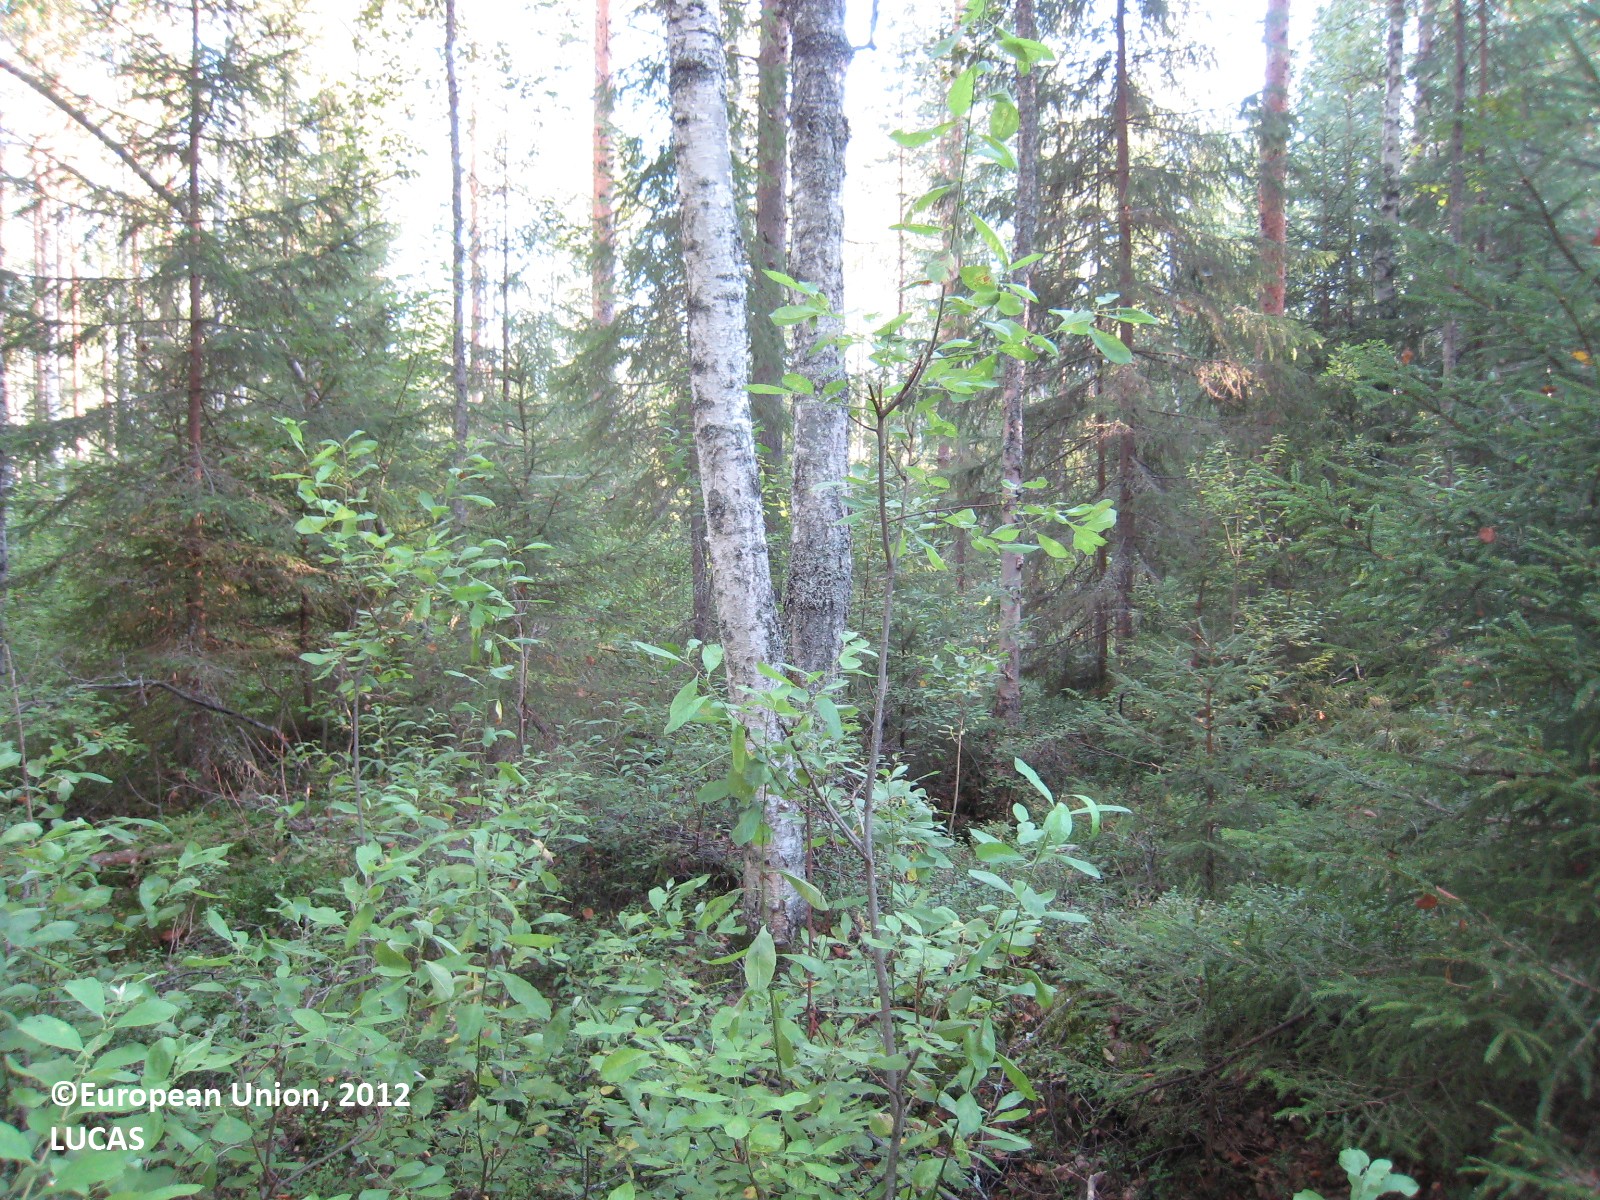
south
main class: Woodland
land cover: Other mixed woodland
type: boreal forest
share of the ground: > 75 %
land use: Forestry
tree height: > 5 m
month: August
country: FI
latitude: 62.1024
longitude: 27.2725
